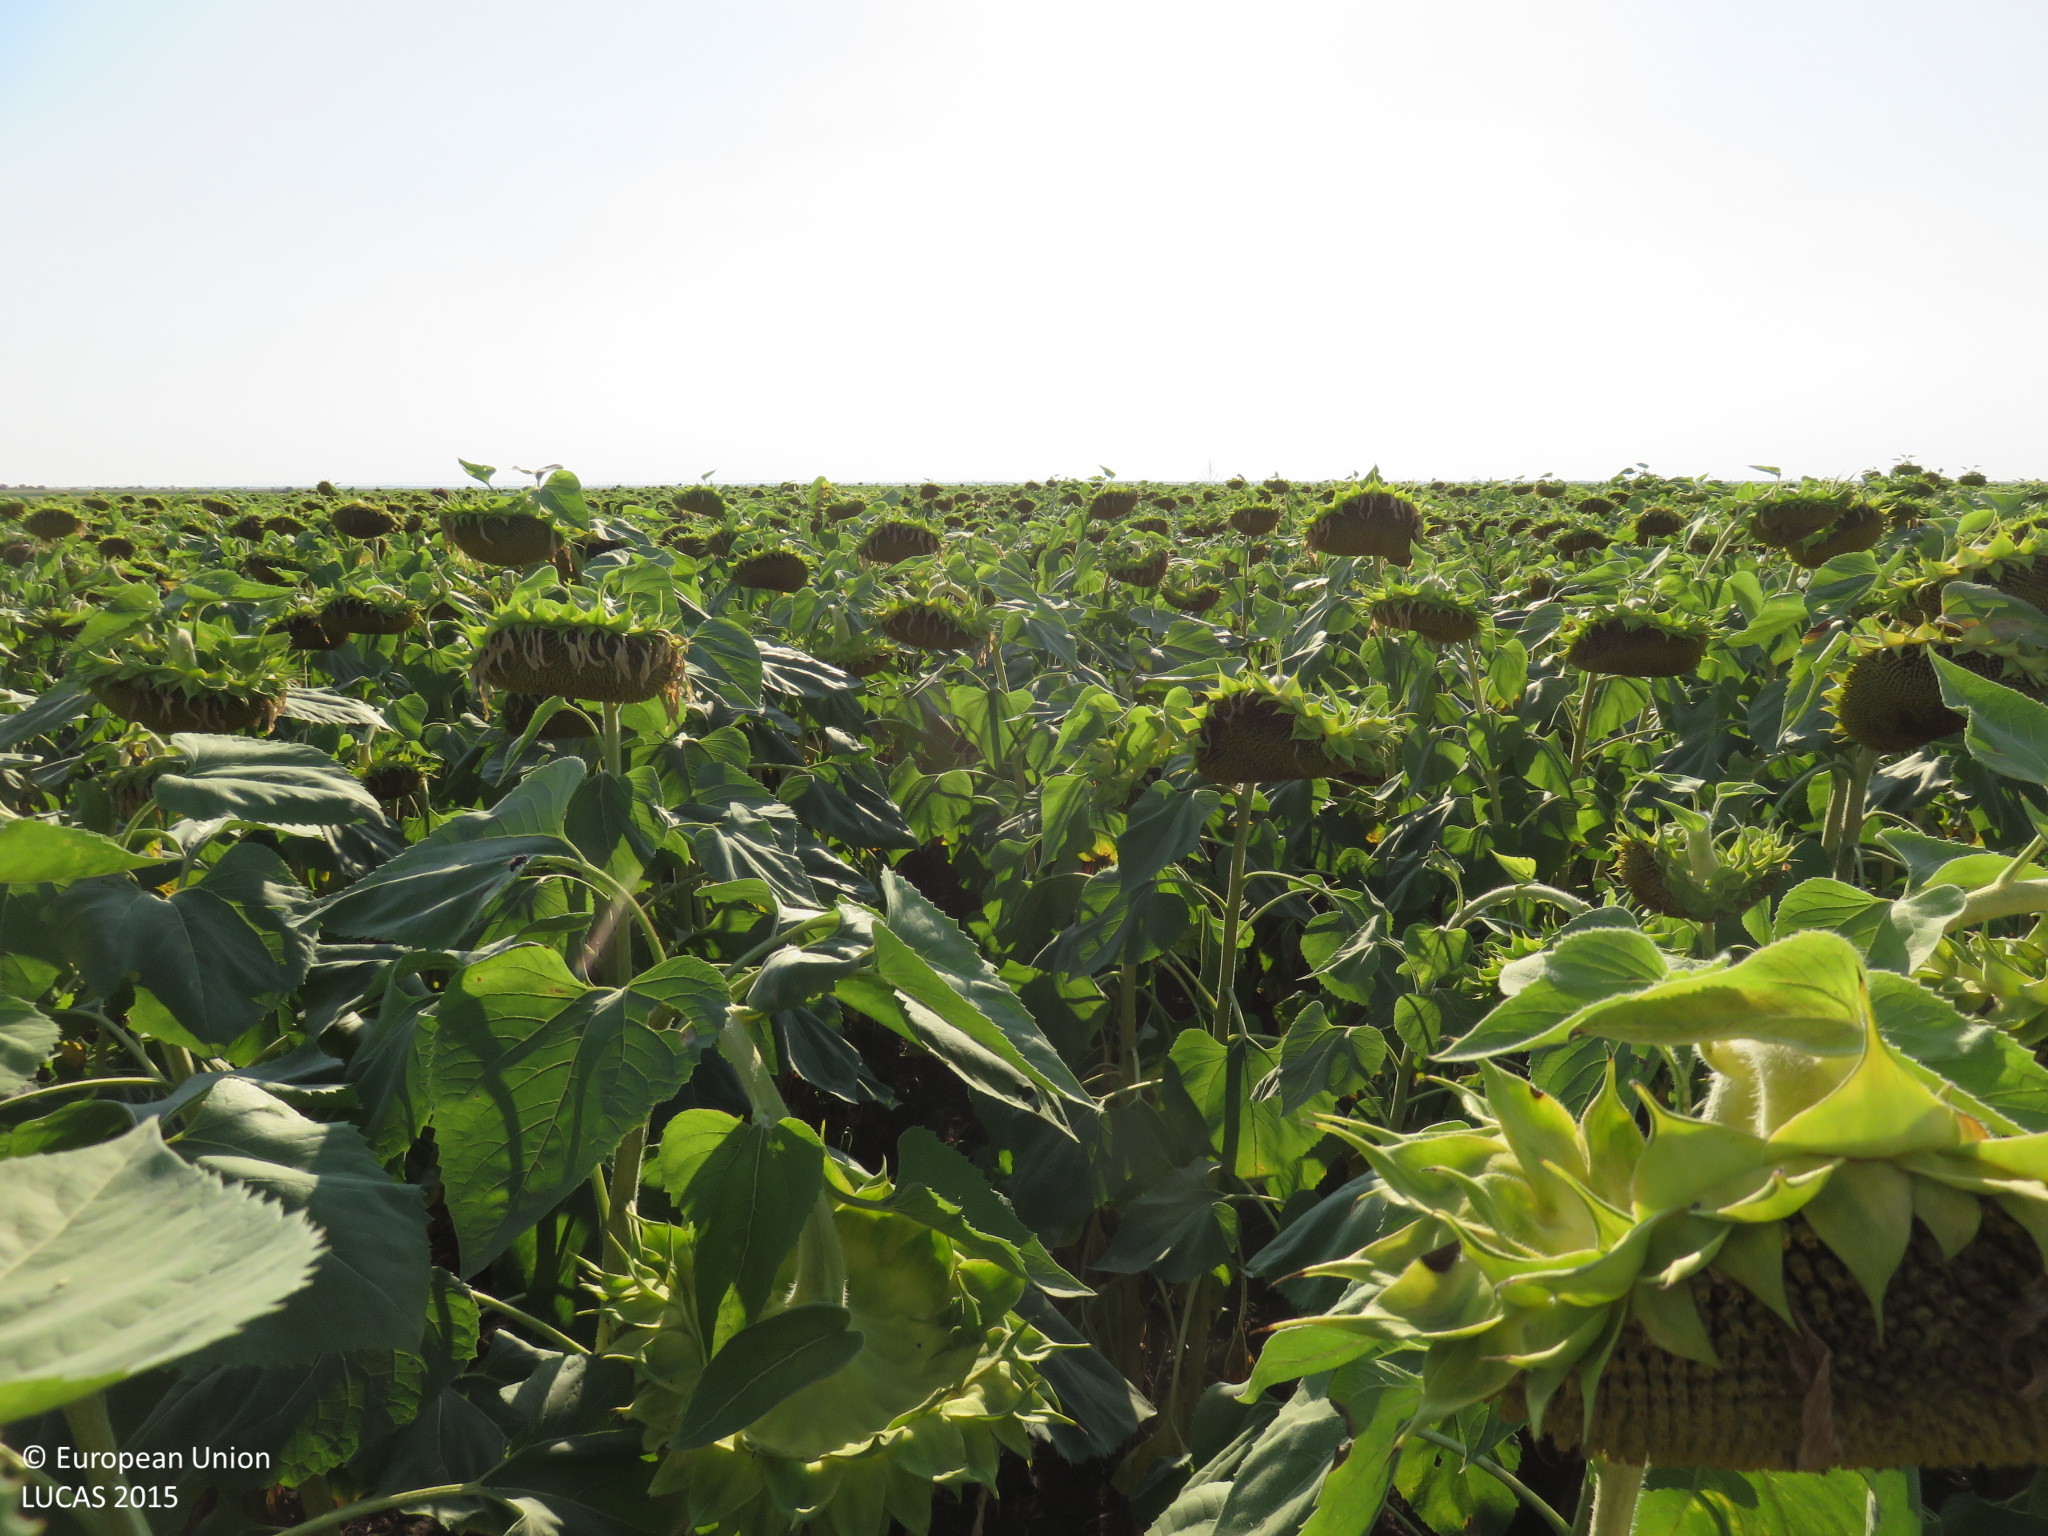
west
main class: Cropland
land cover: Sunflower
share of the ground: > 75 %
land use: Agriculture (excluding fallow land and kitchen gardens)
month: July
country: BG
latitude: 43.3854
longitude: 25.0947
